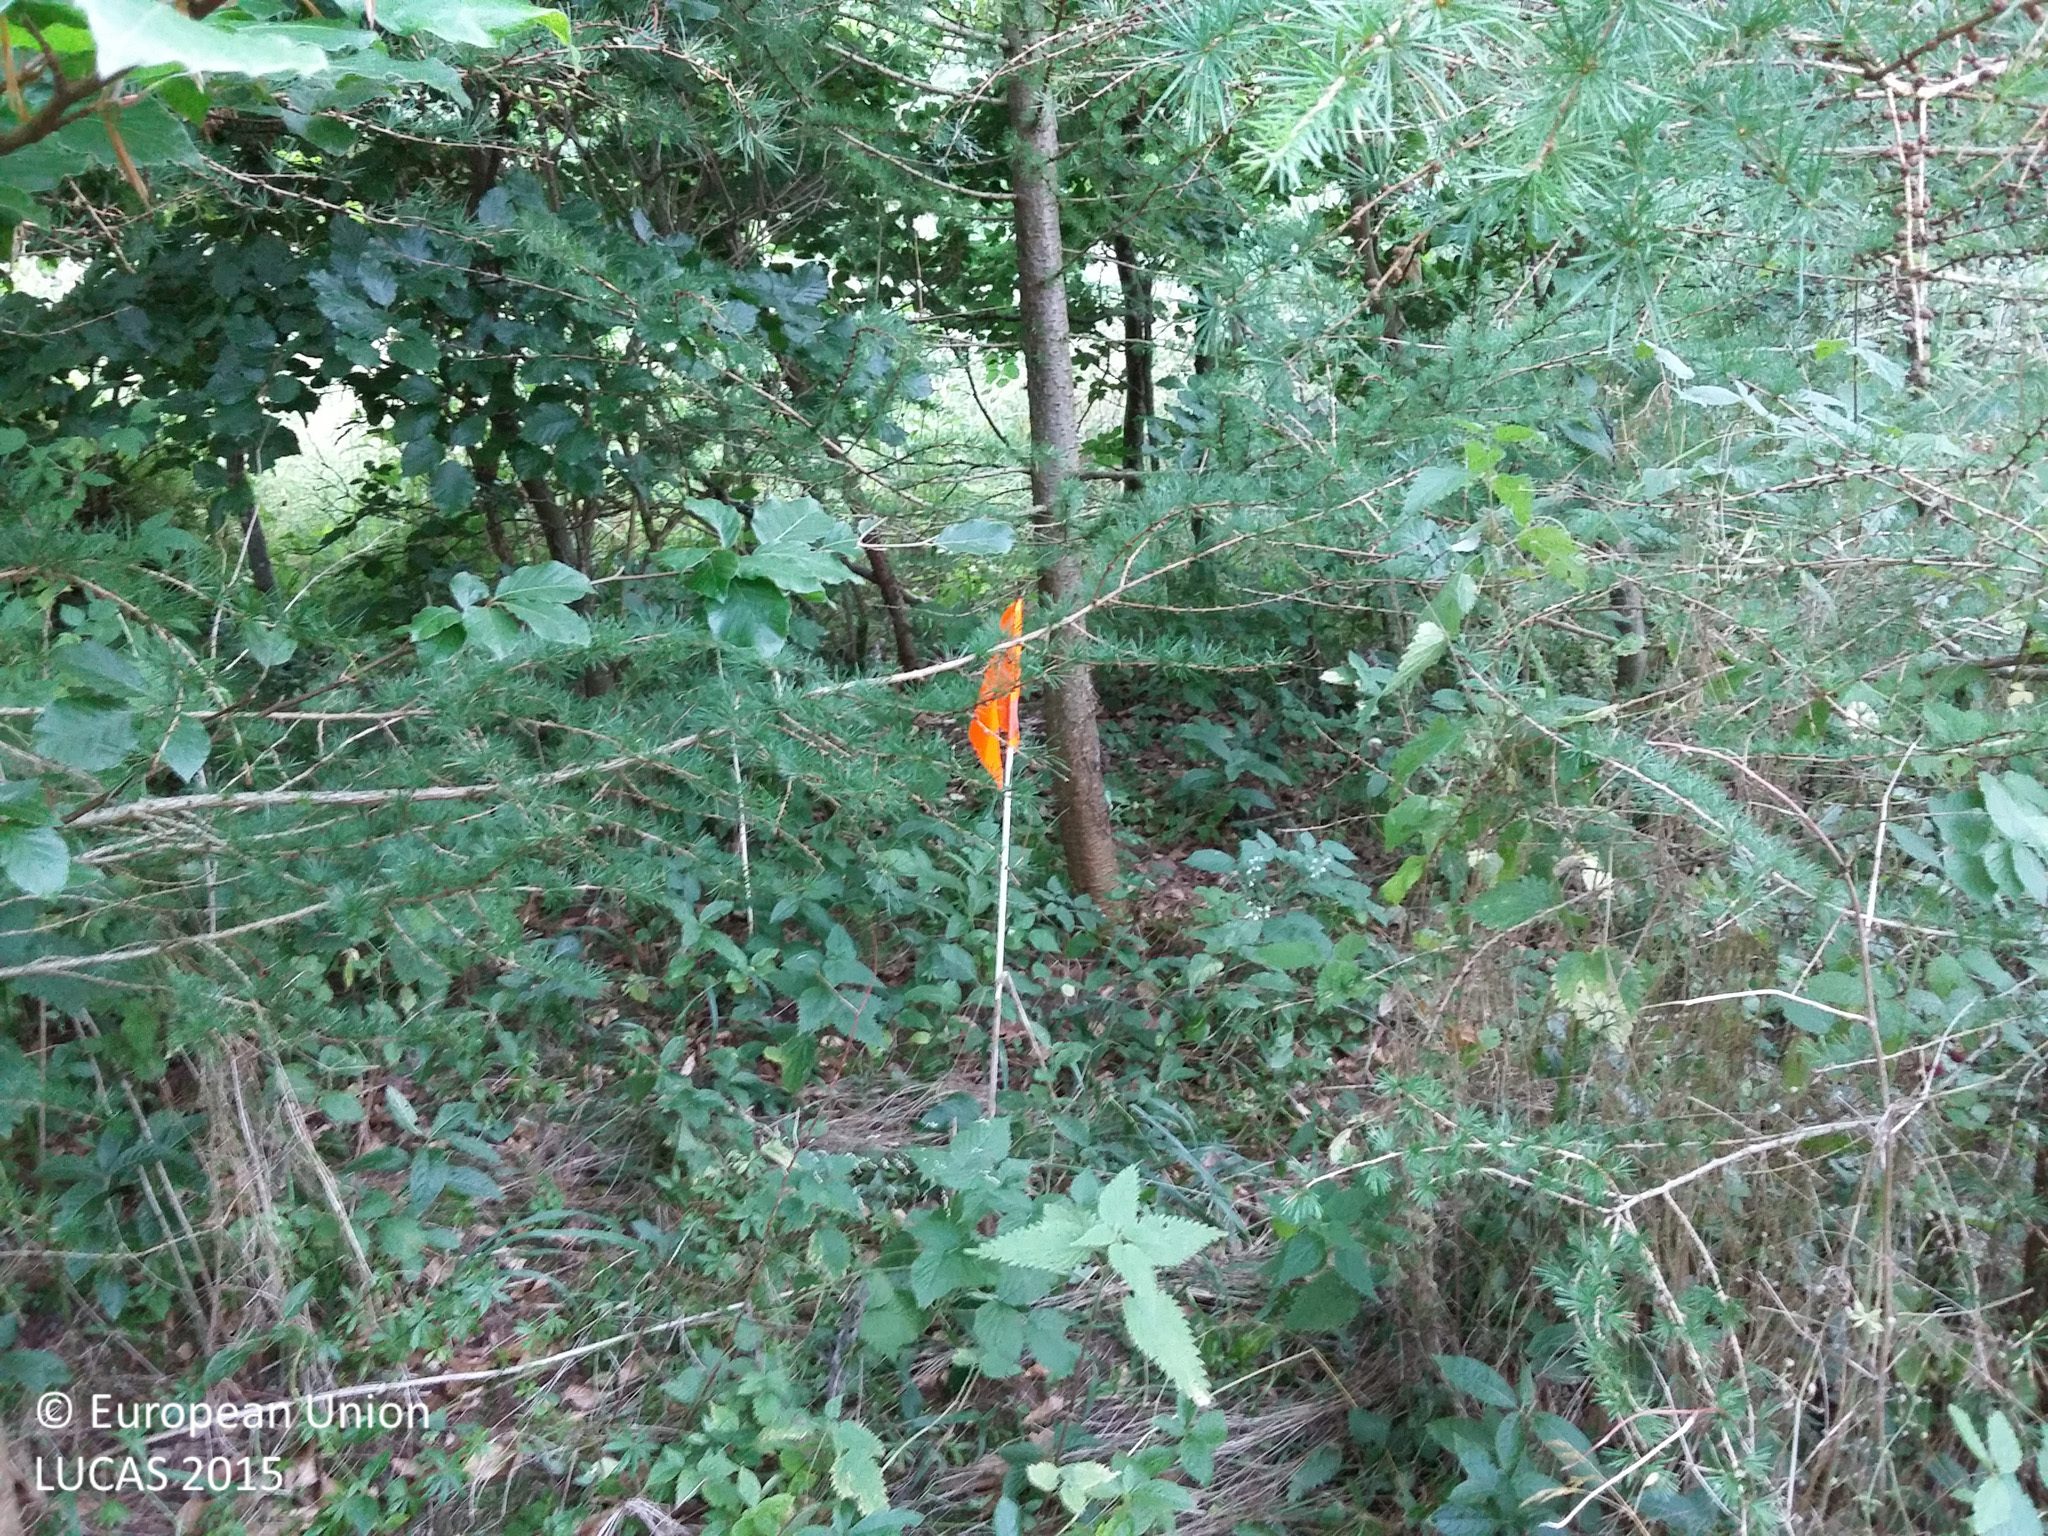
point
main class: Woodland
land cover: Other mixed woodland
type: beech forest
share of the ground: > 75 %
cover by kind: coniferous forest trees 50 %, broadleaved forest trees 40 %, shrubs 5 %, herbaceous plants 5 %
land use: Forestry
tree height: > 5 m
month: August
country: DK
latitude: 55.3625
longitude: 12.0335
